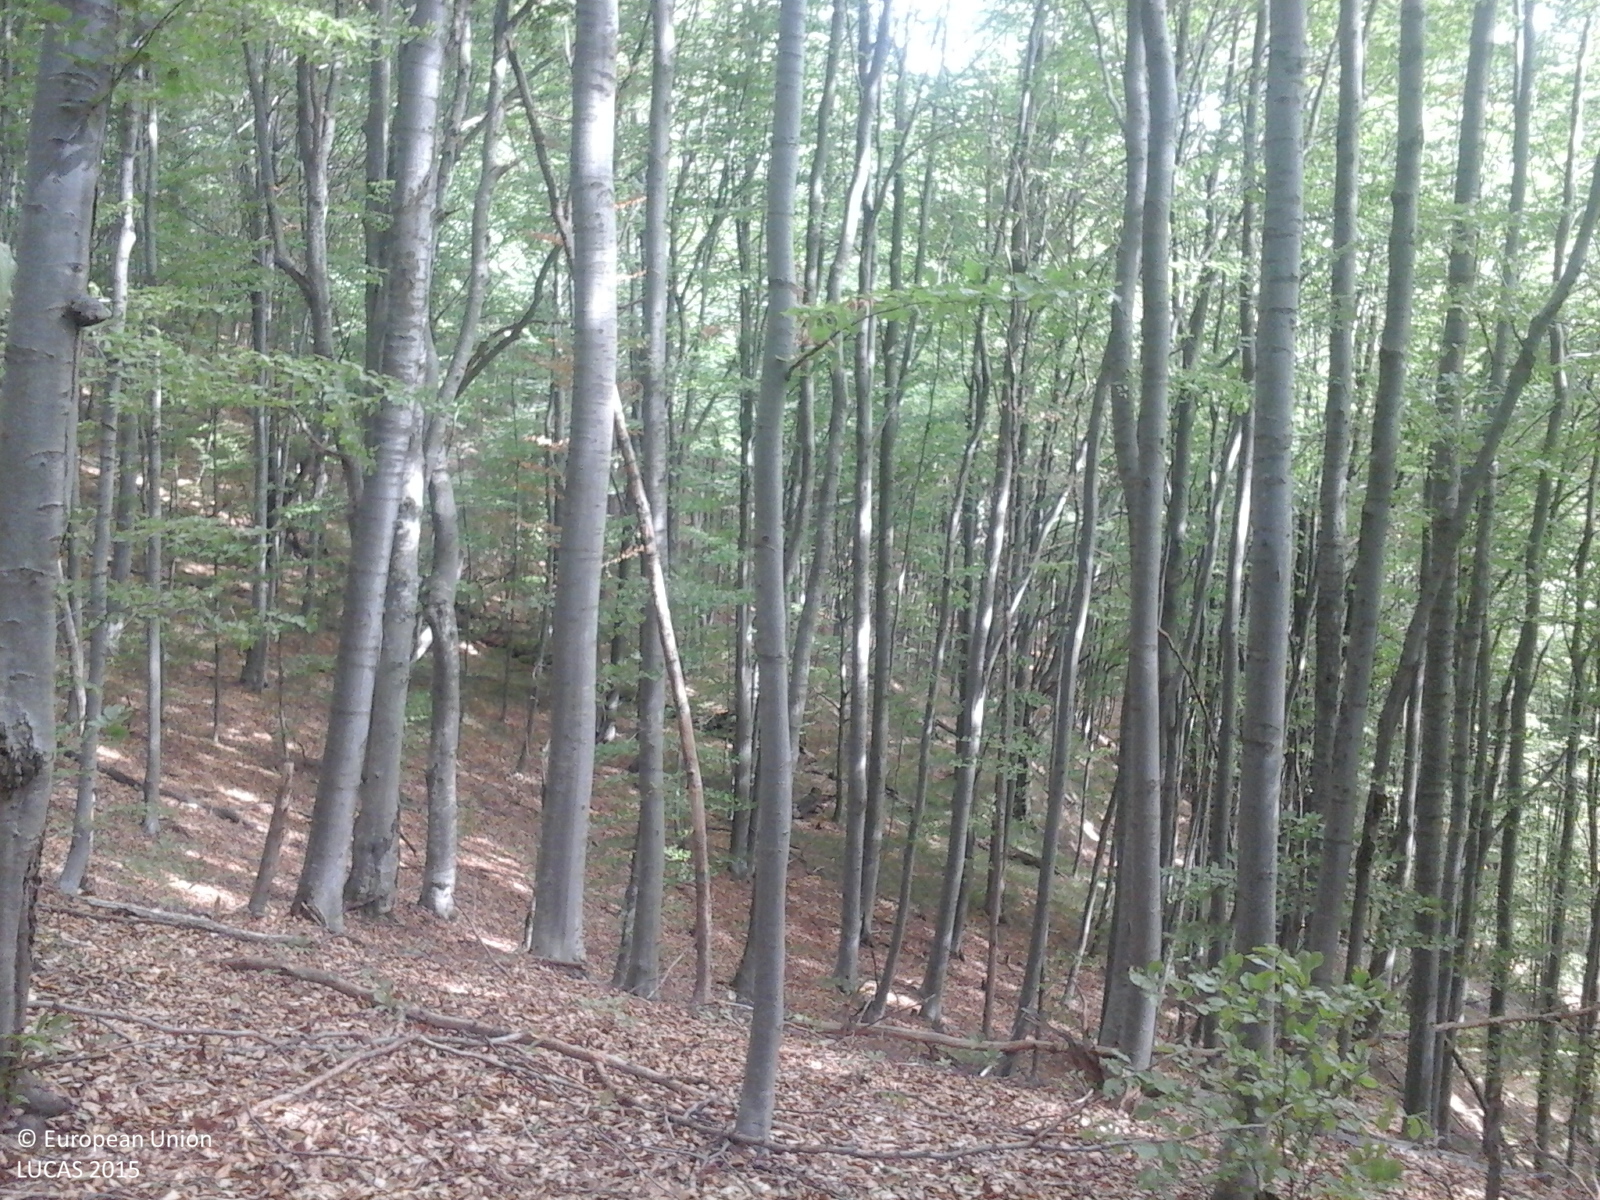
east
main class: Woodland
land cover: Broadleaved woodland
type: mesophytic deciduous forest
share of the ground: > 75 %
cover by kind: broadleaved forest trees 100 %
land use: Forestry
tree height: > 5 m
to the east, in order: Broadleaved woodland; Grassland without tree/shrub cover; Broadleaved woodland
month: September
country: RO
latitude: 47.3756
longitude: 24.0290
